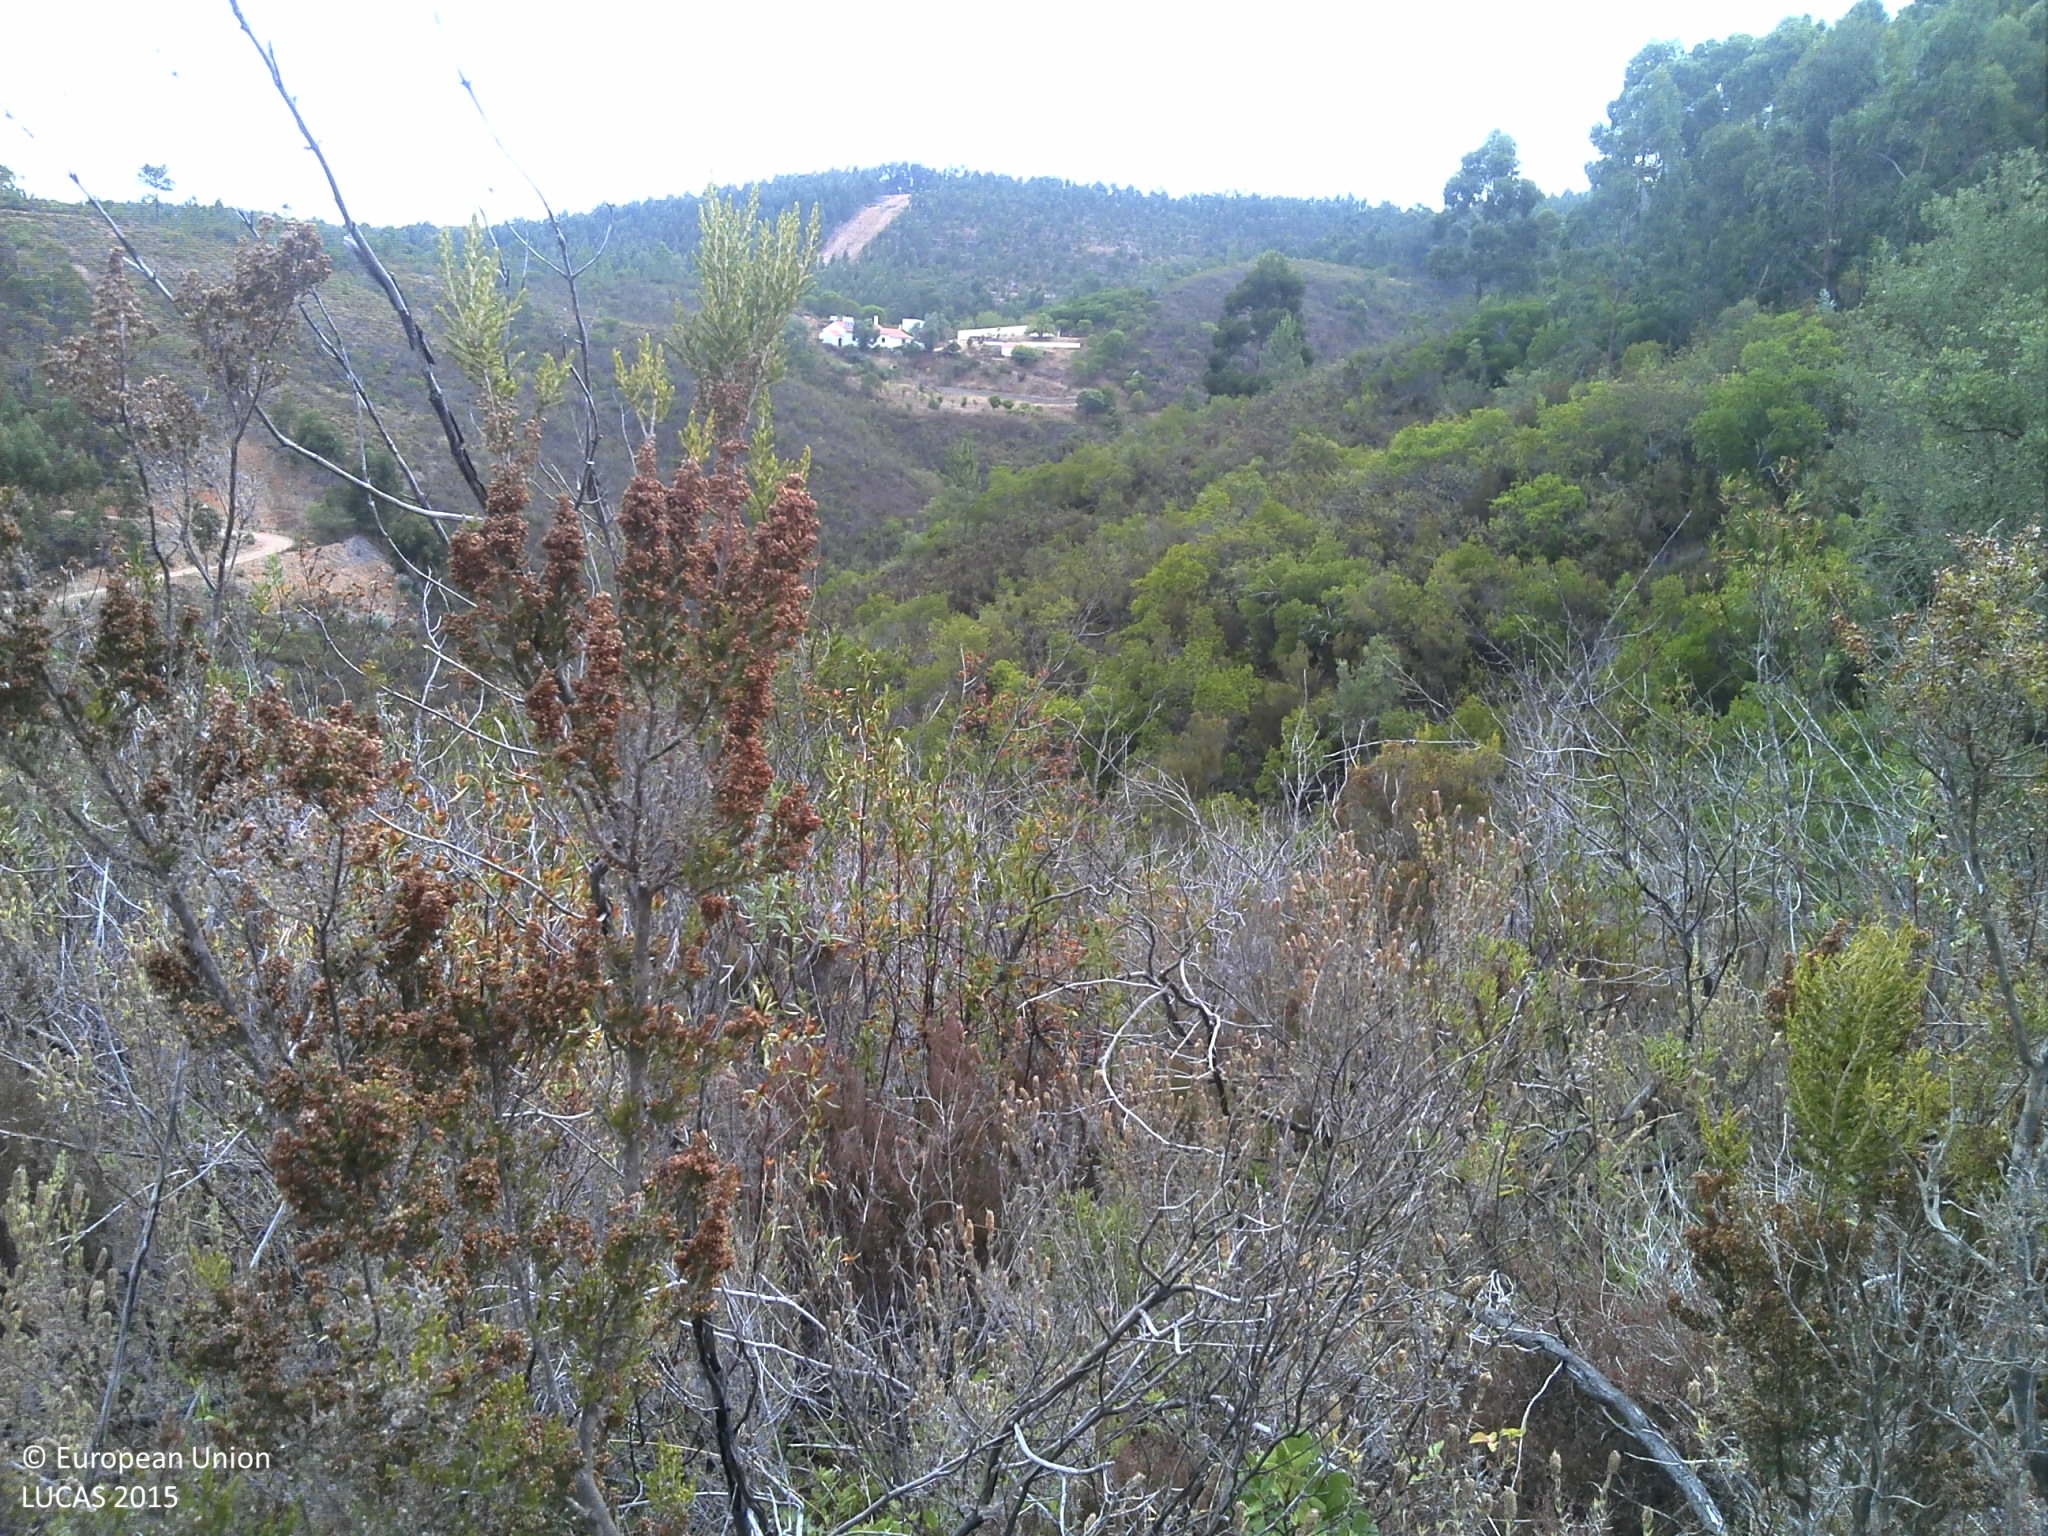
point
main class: Shrubland
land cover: Shrubland with sparse tree cover
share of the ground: > 75 %
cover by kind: shrubs 75 %, herbaceous plants 15 %, broadleaved forest trees 5 %, unconsolidated bare surface 5 %
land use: Abandoned areas
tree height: < 5 m
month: July
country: PT
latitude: 37.3499
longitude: -8.7411
